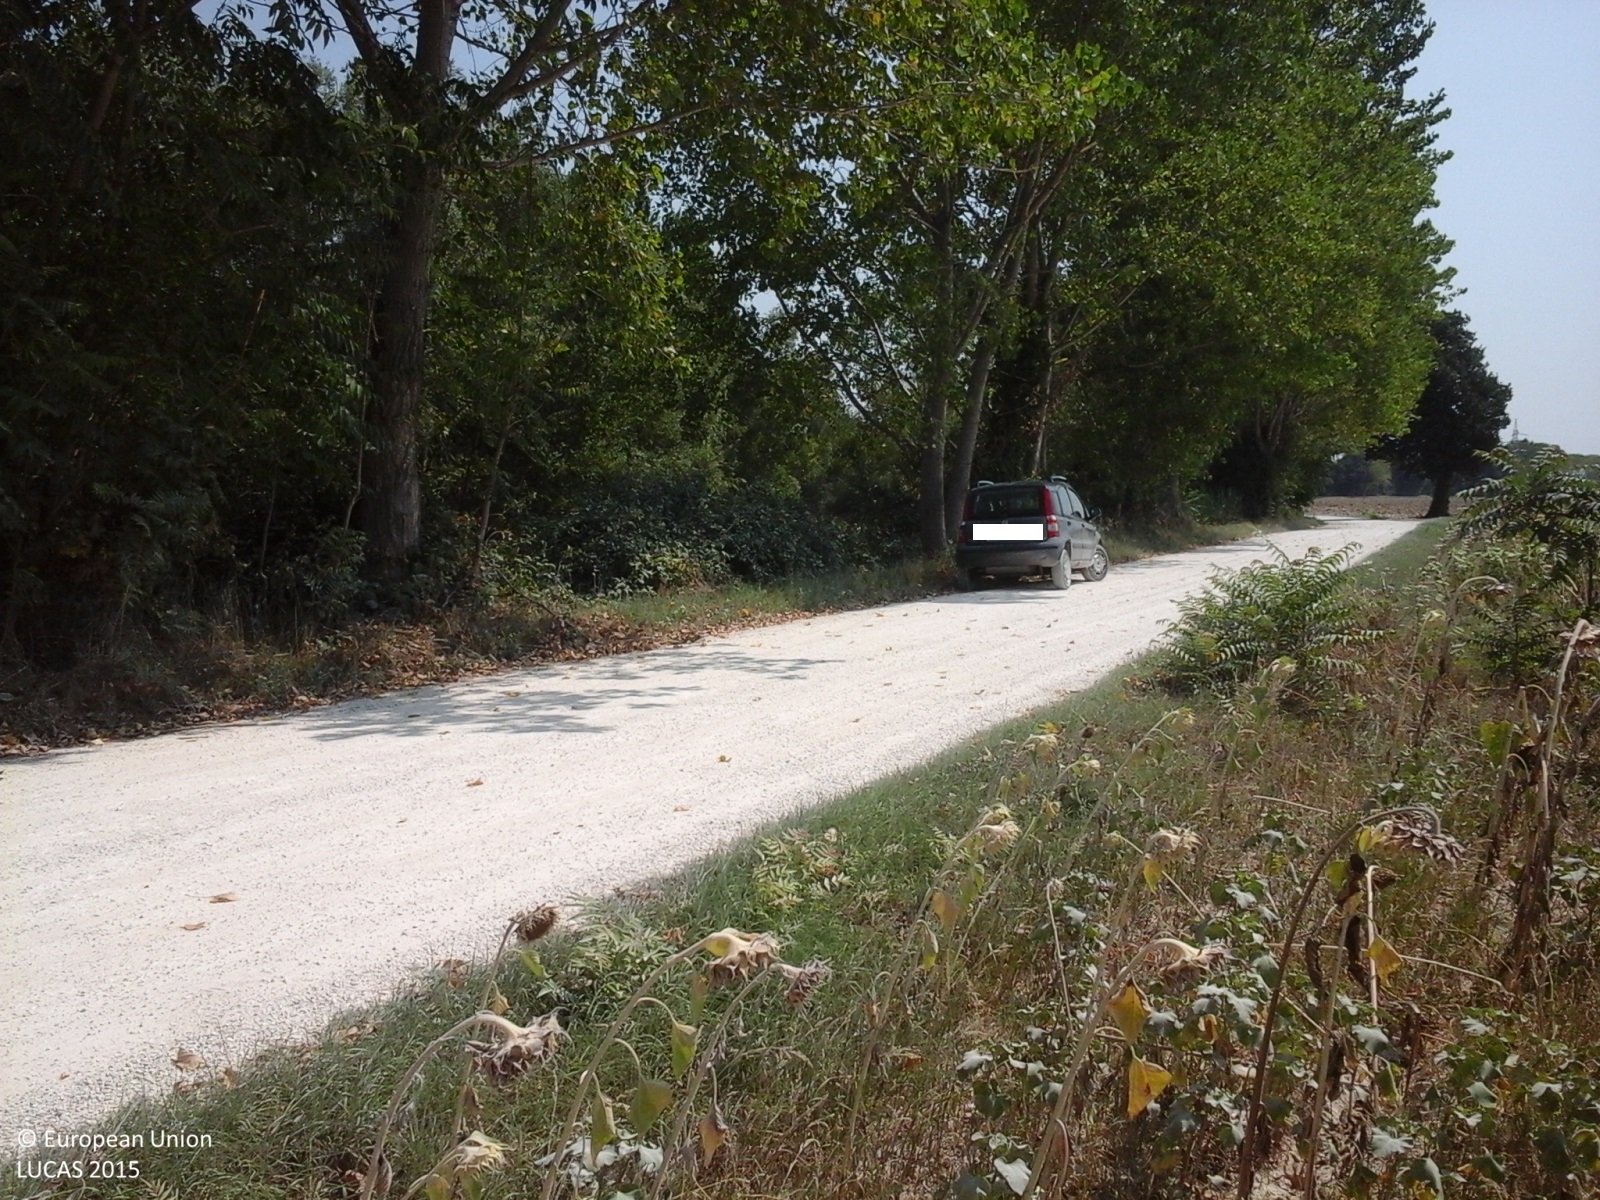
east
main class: Cropland
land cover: Sunflower
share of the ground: > 75 %
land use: Agriculture (excluding fallow land and kitchen gardens)
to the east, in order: Sunflower; Paved roads, cycling and walking lanes; Broadleaved woodland; Rivers and streams; Broadleaved woodland; Rivers and streams; Broadleaved woodland; Rivers and streams; Broadleaved woodland; Rivers and streams; Broadleaved woodland; Rivers and streams
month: August
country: IT
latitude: 43.4621
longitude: 13.4646
